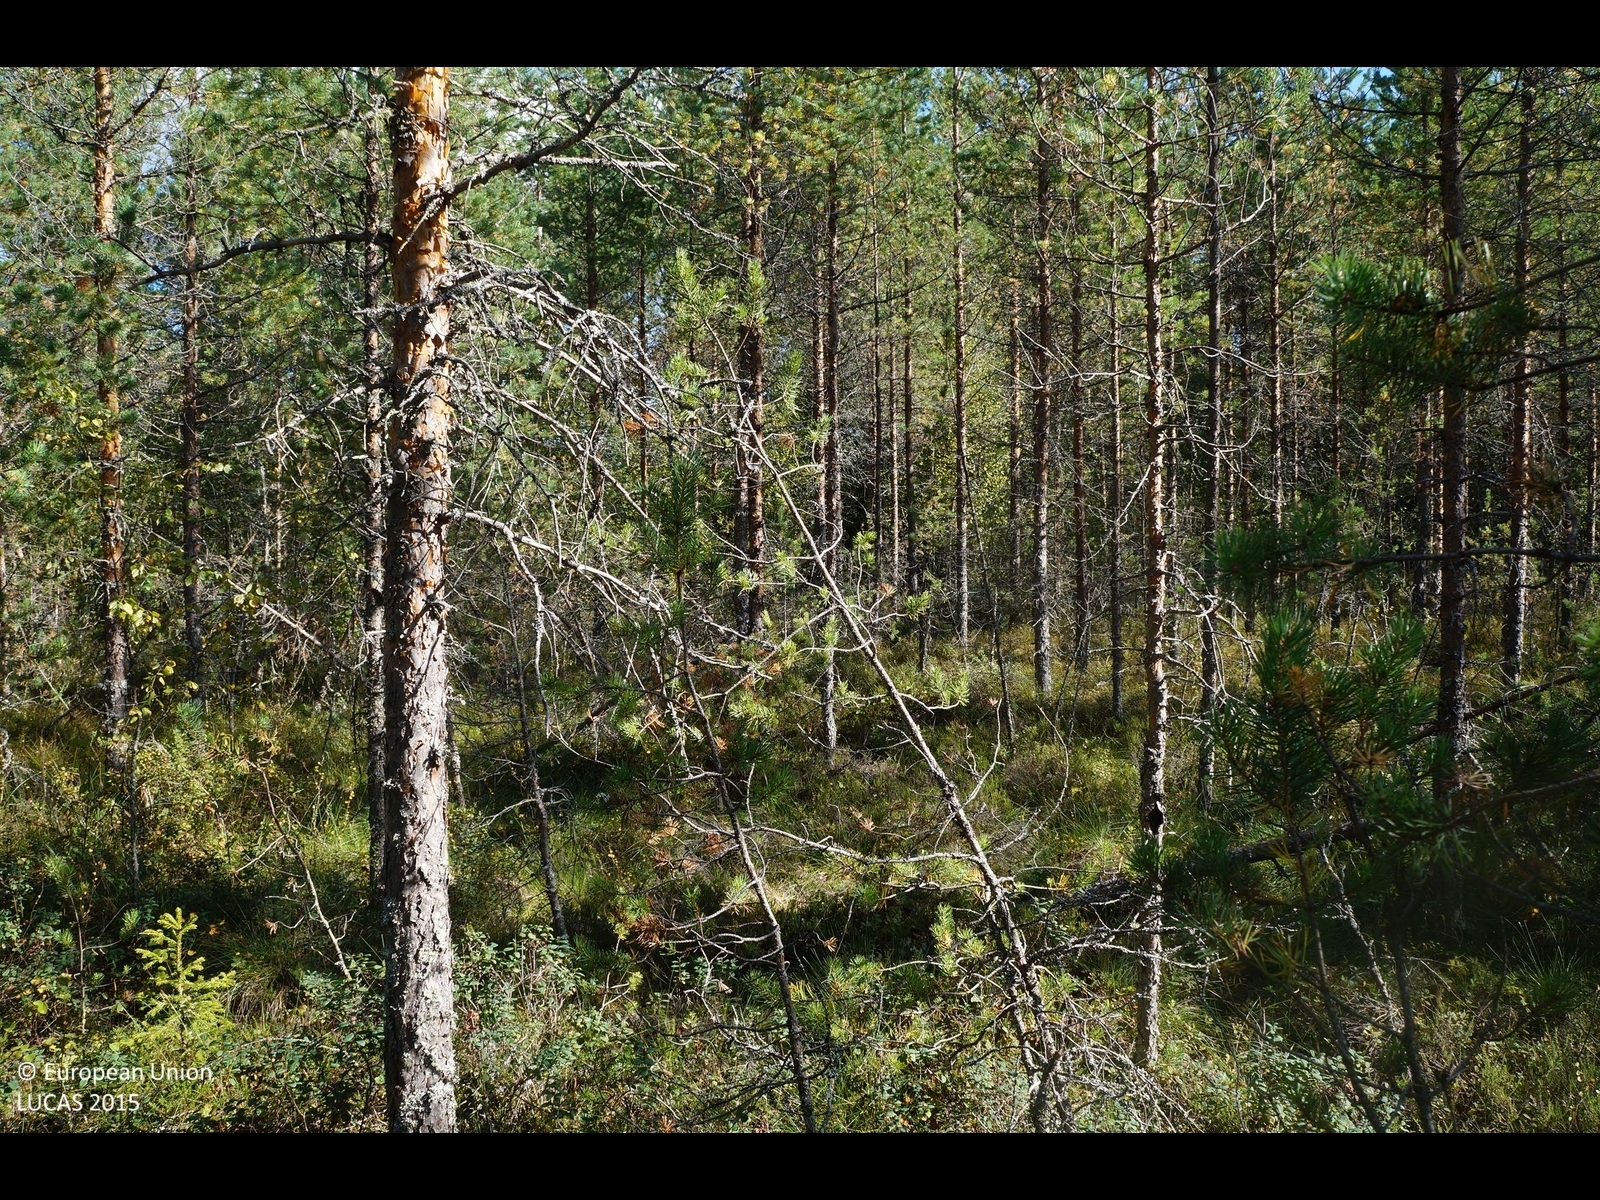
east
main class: Woodland
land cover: Pine dominated coniferous woodland
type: boreal forest
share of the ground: 50 - 75 %
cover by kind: coniferous forest trees 55 %, shrubs 30 %, lichens and mosses 10 %, herbaceous plants 5 %
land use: Forestry
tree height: > 5 m
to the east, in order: Pine dominated coniferous woodland; Ditches and canals; Pine dominated mixed woodland; Broadleaved woodland; Spruce dominated mixed woodland; Ditches and canals; Spruce dominated mixed woodland; Ditches and canals; Broadleaved woodland; Spruce dominated mixed woodland; Ditches and canals; Spruce dominated mixed woodland; Ditches and canals; Spruce dominated mixed woodland; Ditches and canals; Spruce dominated mixed woodland; Pine dominated mixed woodland; Ditches and canals; Spruce dominated mixed woodland; Ditches and canals; Pine dominated mixed woodland
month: September
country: FI
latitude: 63.9944
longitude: 24.4025
